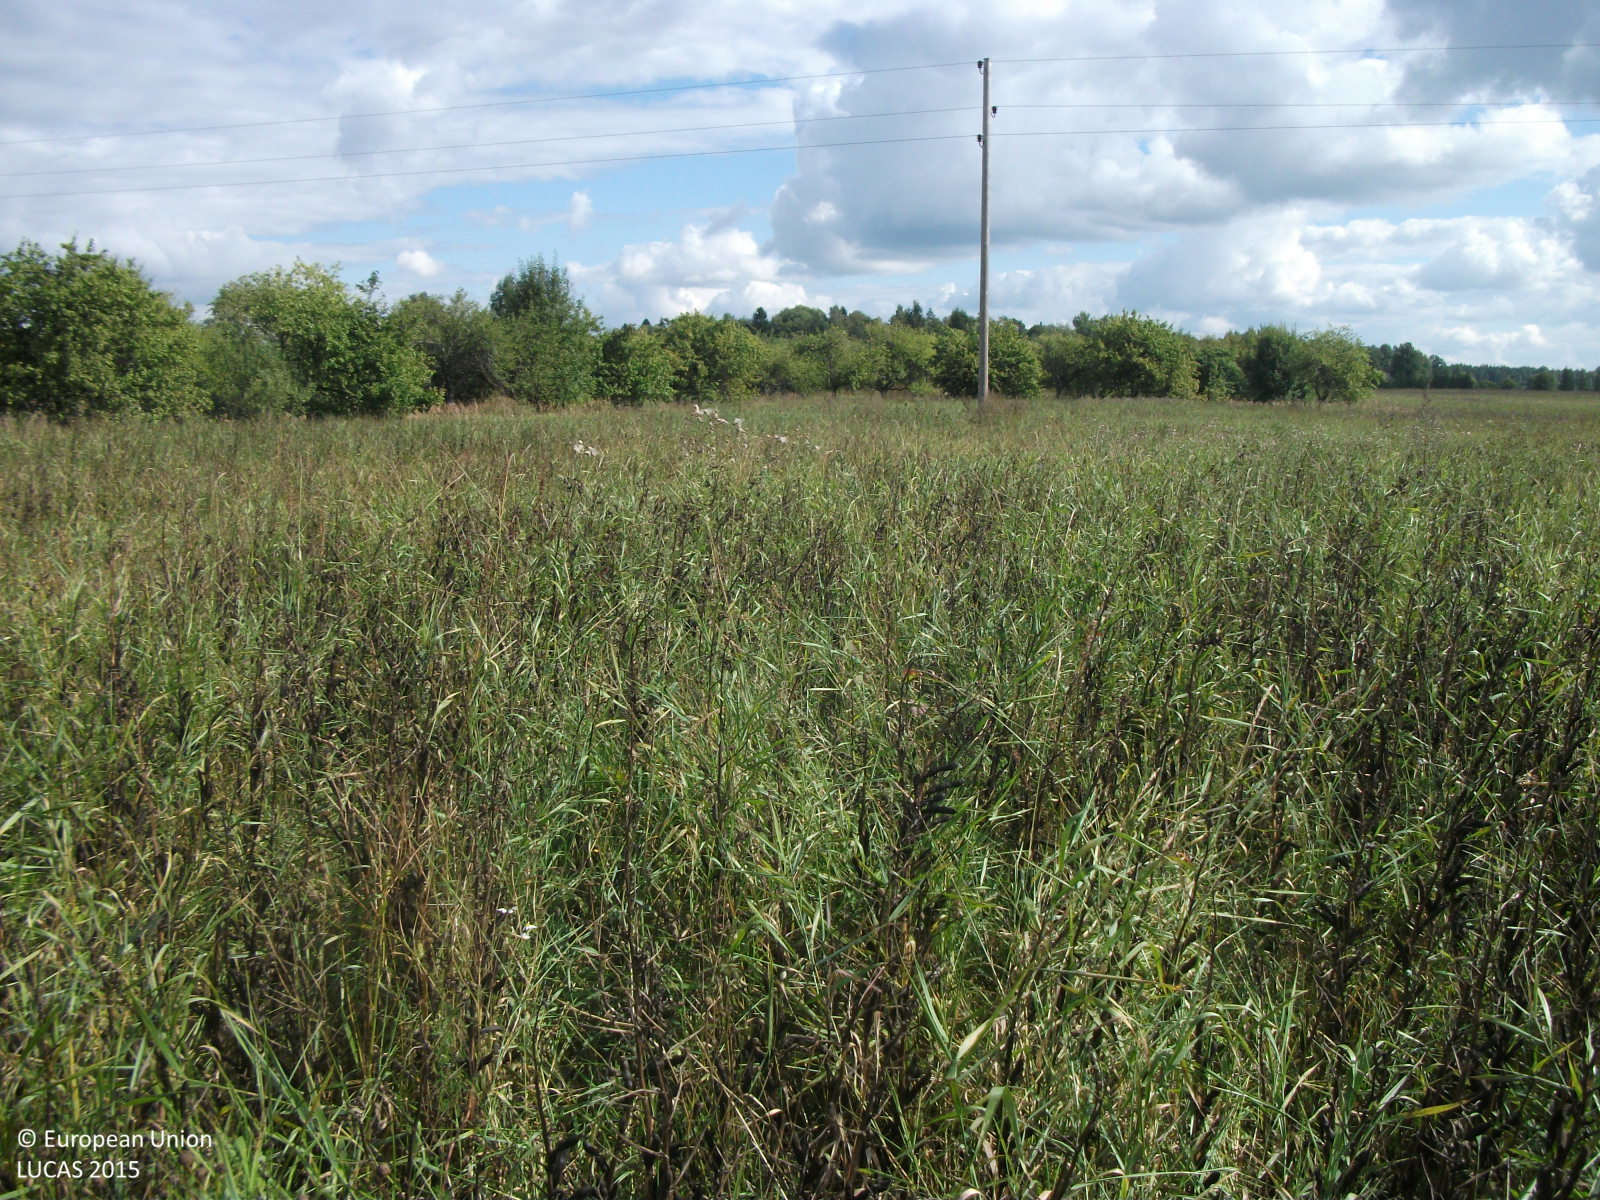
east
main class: Cropland
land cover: Dry pulses
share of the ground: > 75 %
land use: Agriculture (excluding fallow land and kitchen gardens)
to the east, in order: Dry pulses; Electric lines; Dry pulses; Grass margins; Apple fruit
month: September
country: LV
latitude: 57.4837
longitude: 24.4854
